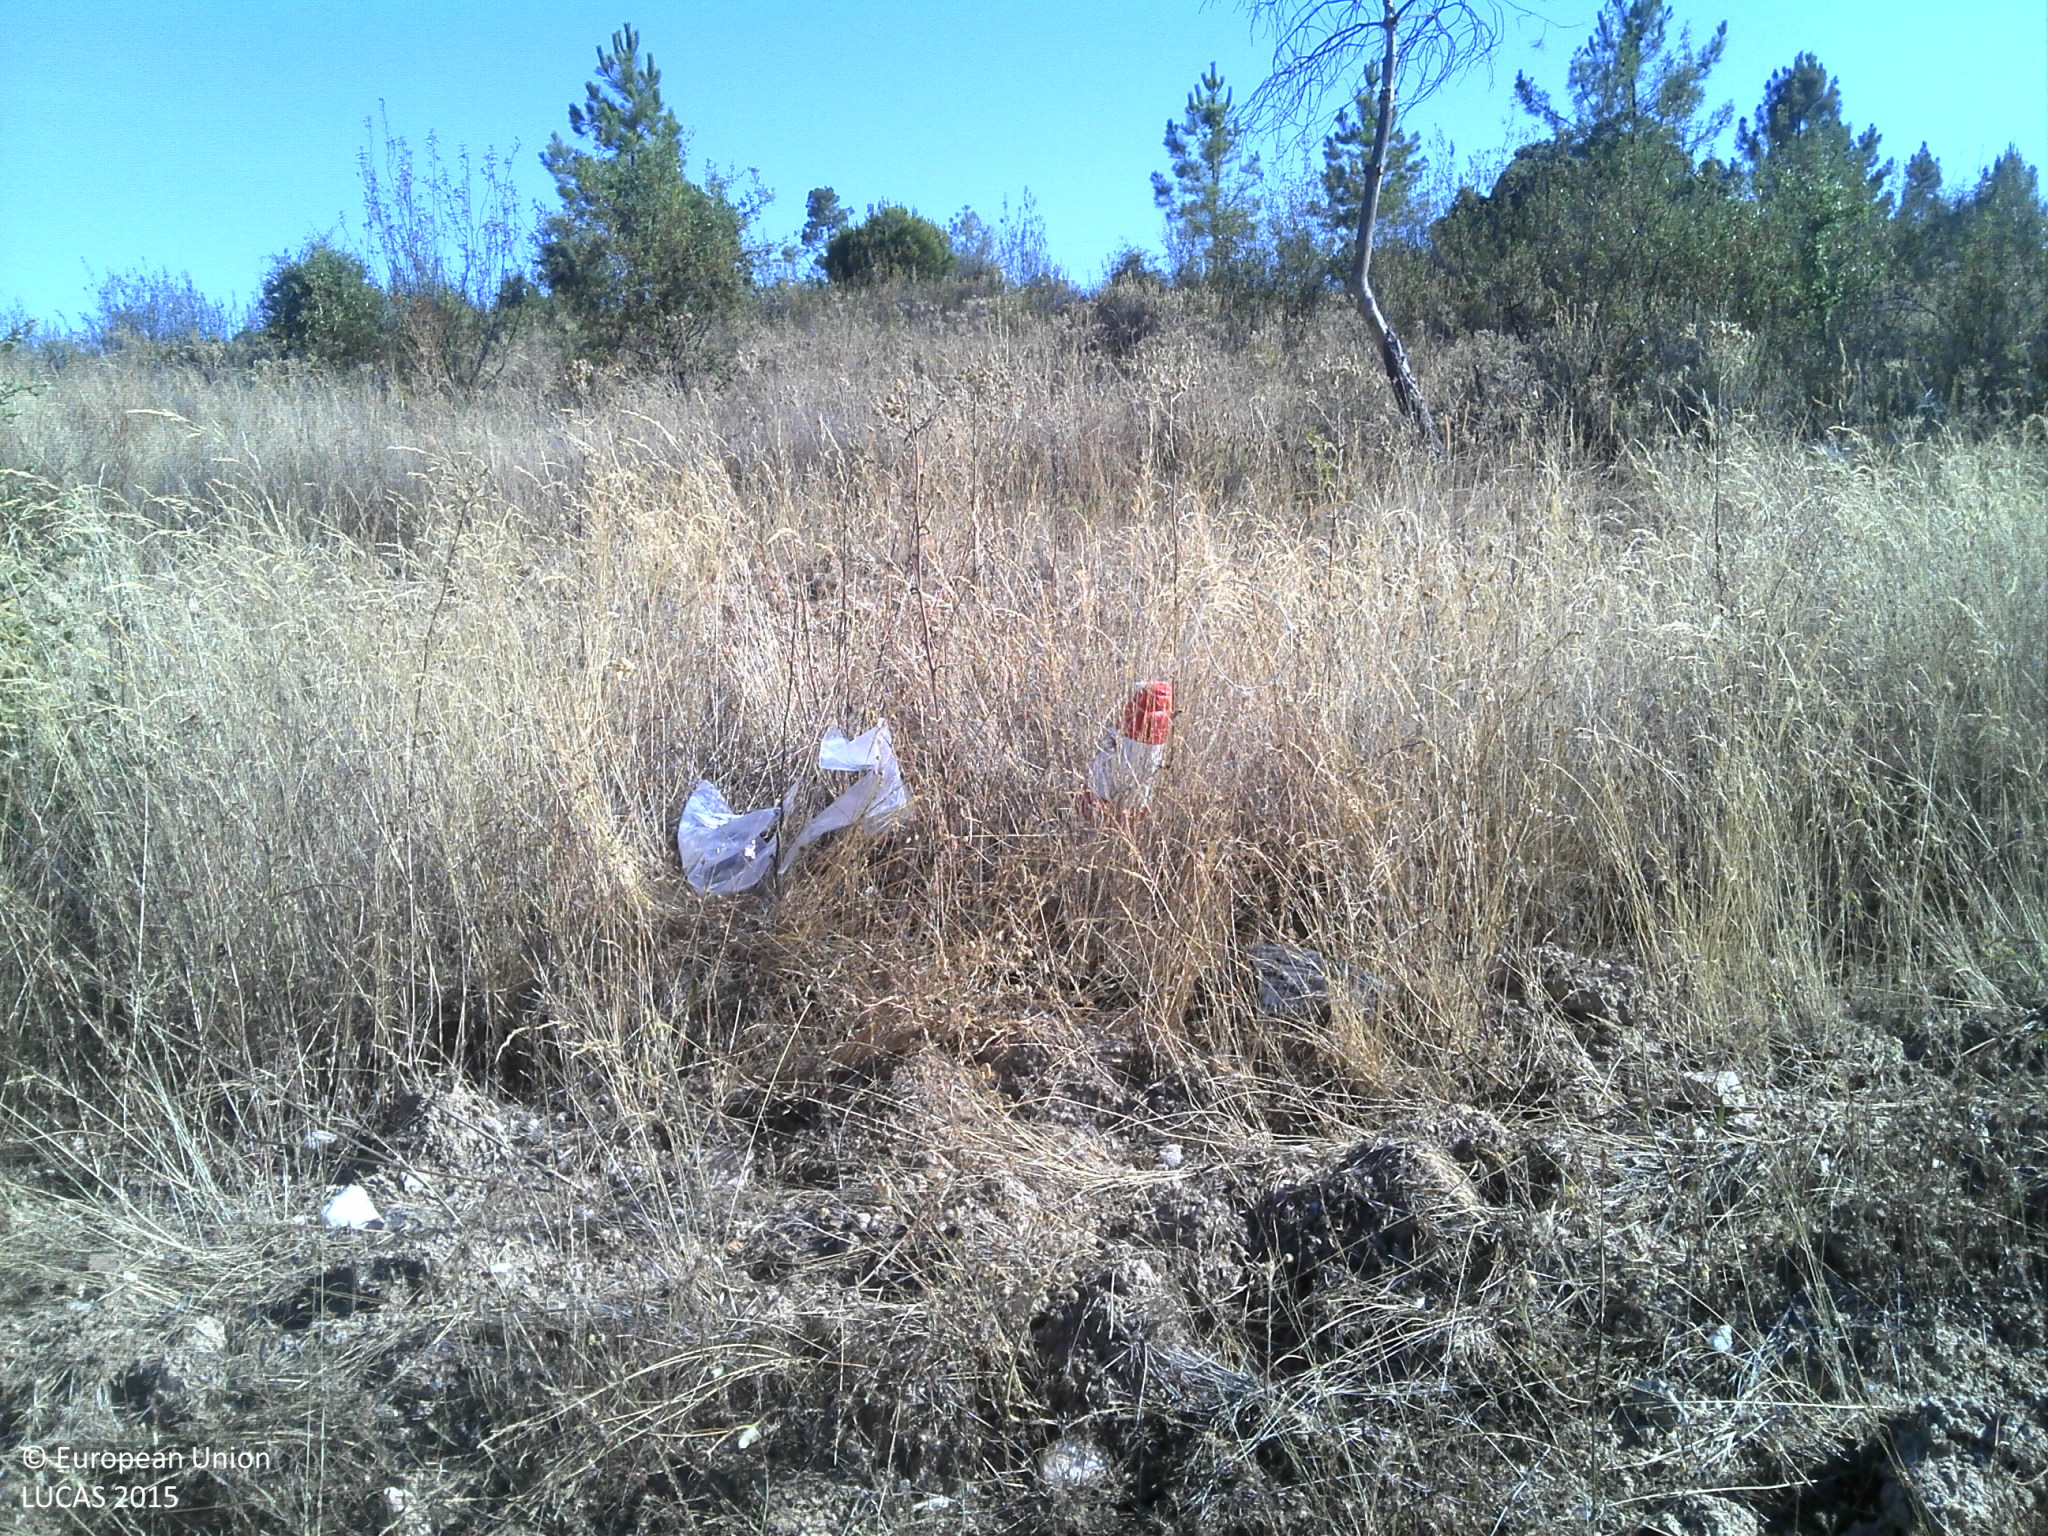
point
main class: Grassland
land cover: Grassland with sparse tree/shrub cover
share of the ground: 25 - 50 %
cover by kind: unconsolidated bare surface 70 %, herbaceous plants 25 %, broadleaved forest trees 5 %
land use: Forestry
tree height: < 5 m
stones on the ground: 10 - 25 %
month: July
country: PT
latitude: 39.9012
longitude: -7.5889
